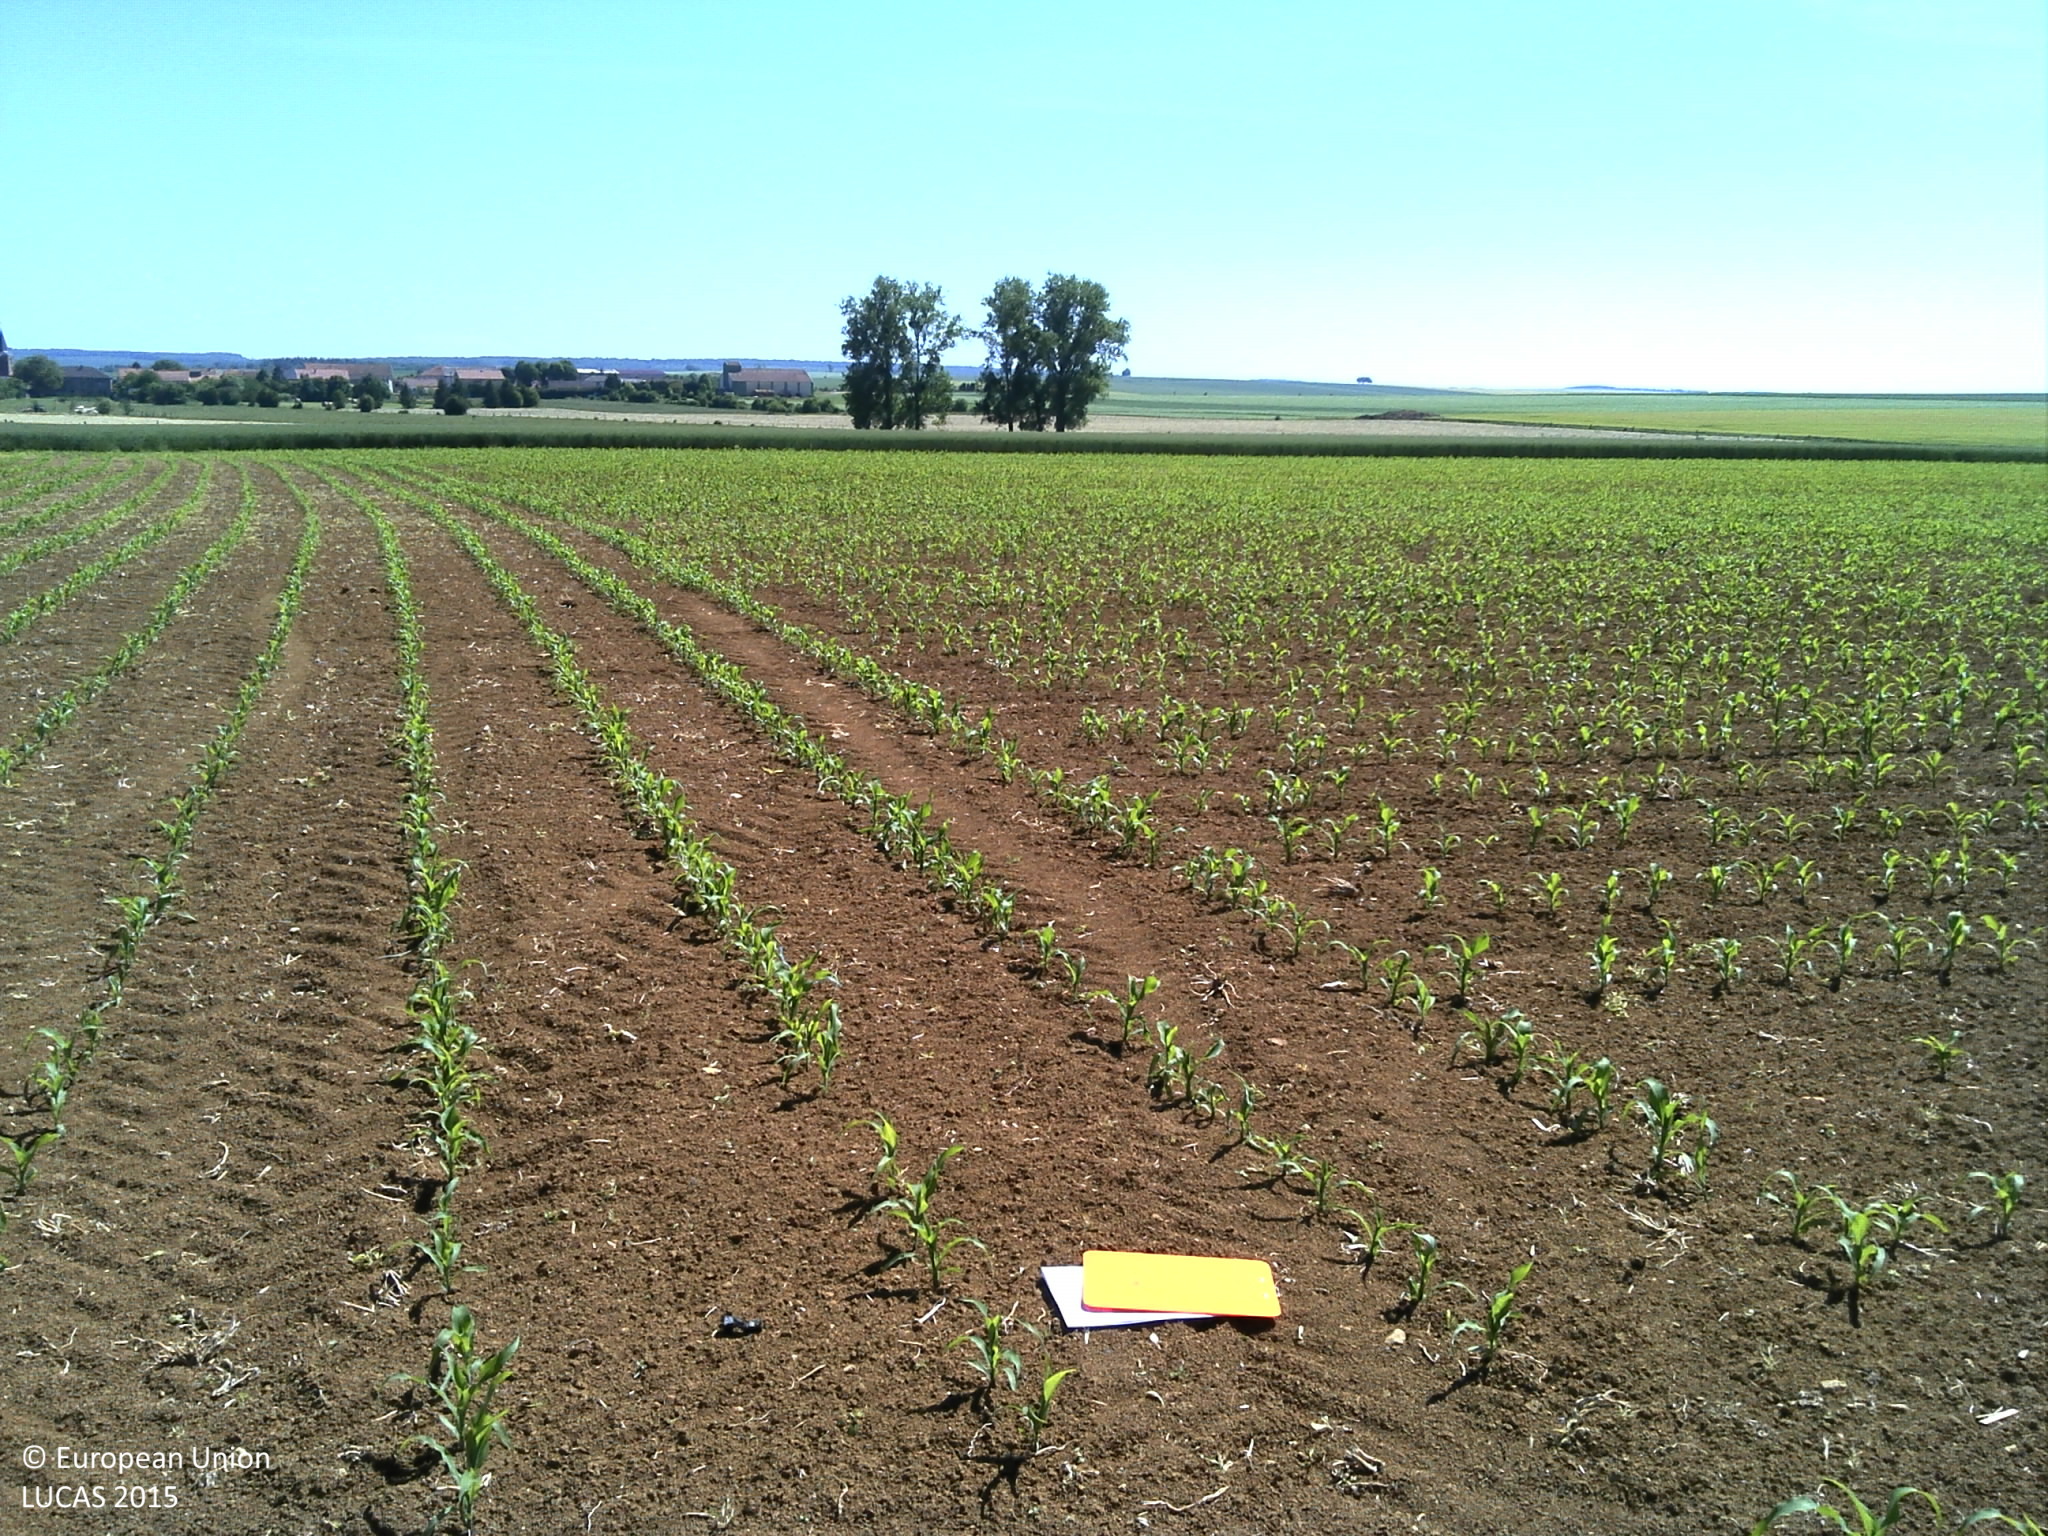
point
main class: Cropland
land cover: Maize
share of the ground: < 10 %
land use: Agriculture (excluding fallow land and kitchen gardens)
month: June
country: FR
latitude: 49.1052
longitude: 5.9860
